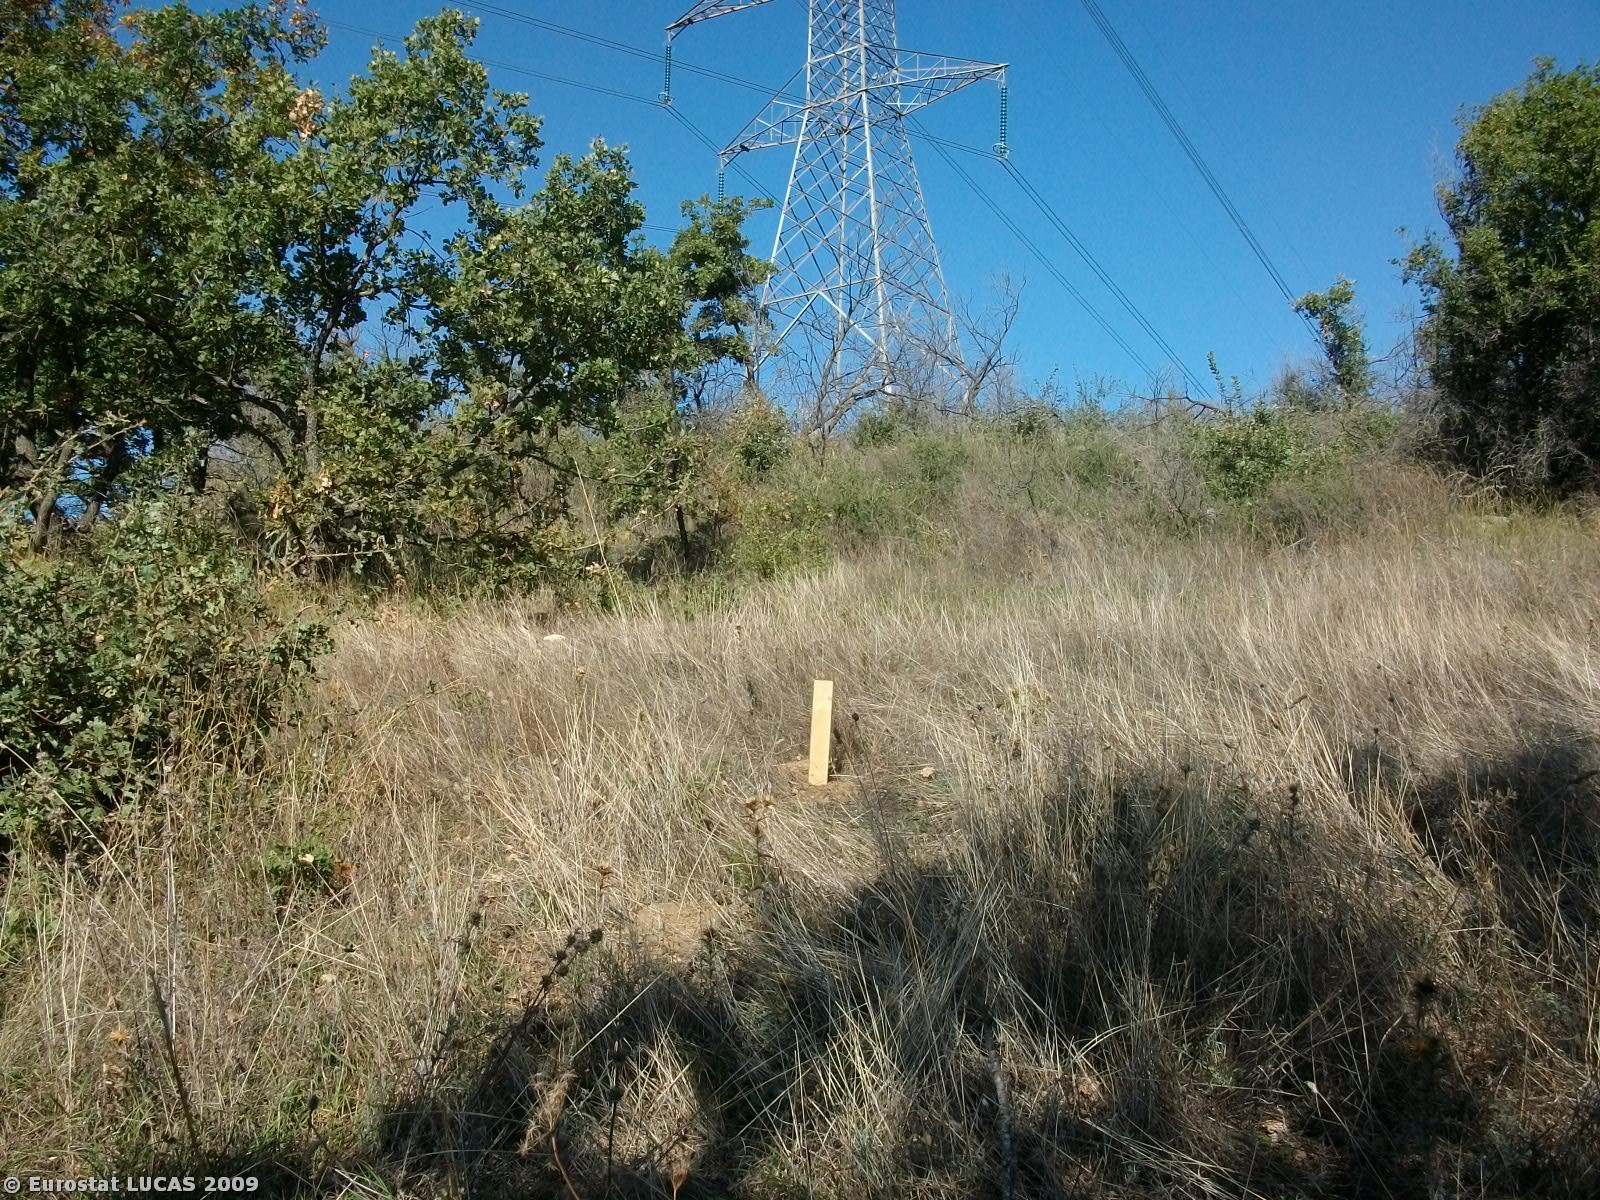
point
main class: Woodland
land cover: Broadleaved woodland
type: thermophilous deciduous forest
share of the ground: 25 - 50 %
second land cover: Grassland with sparse tree/shrub cover
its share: > 75 %
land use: Forestry
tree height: > 5 m
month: October
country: GR
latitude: 39.0829
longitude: 22.4800
